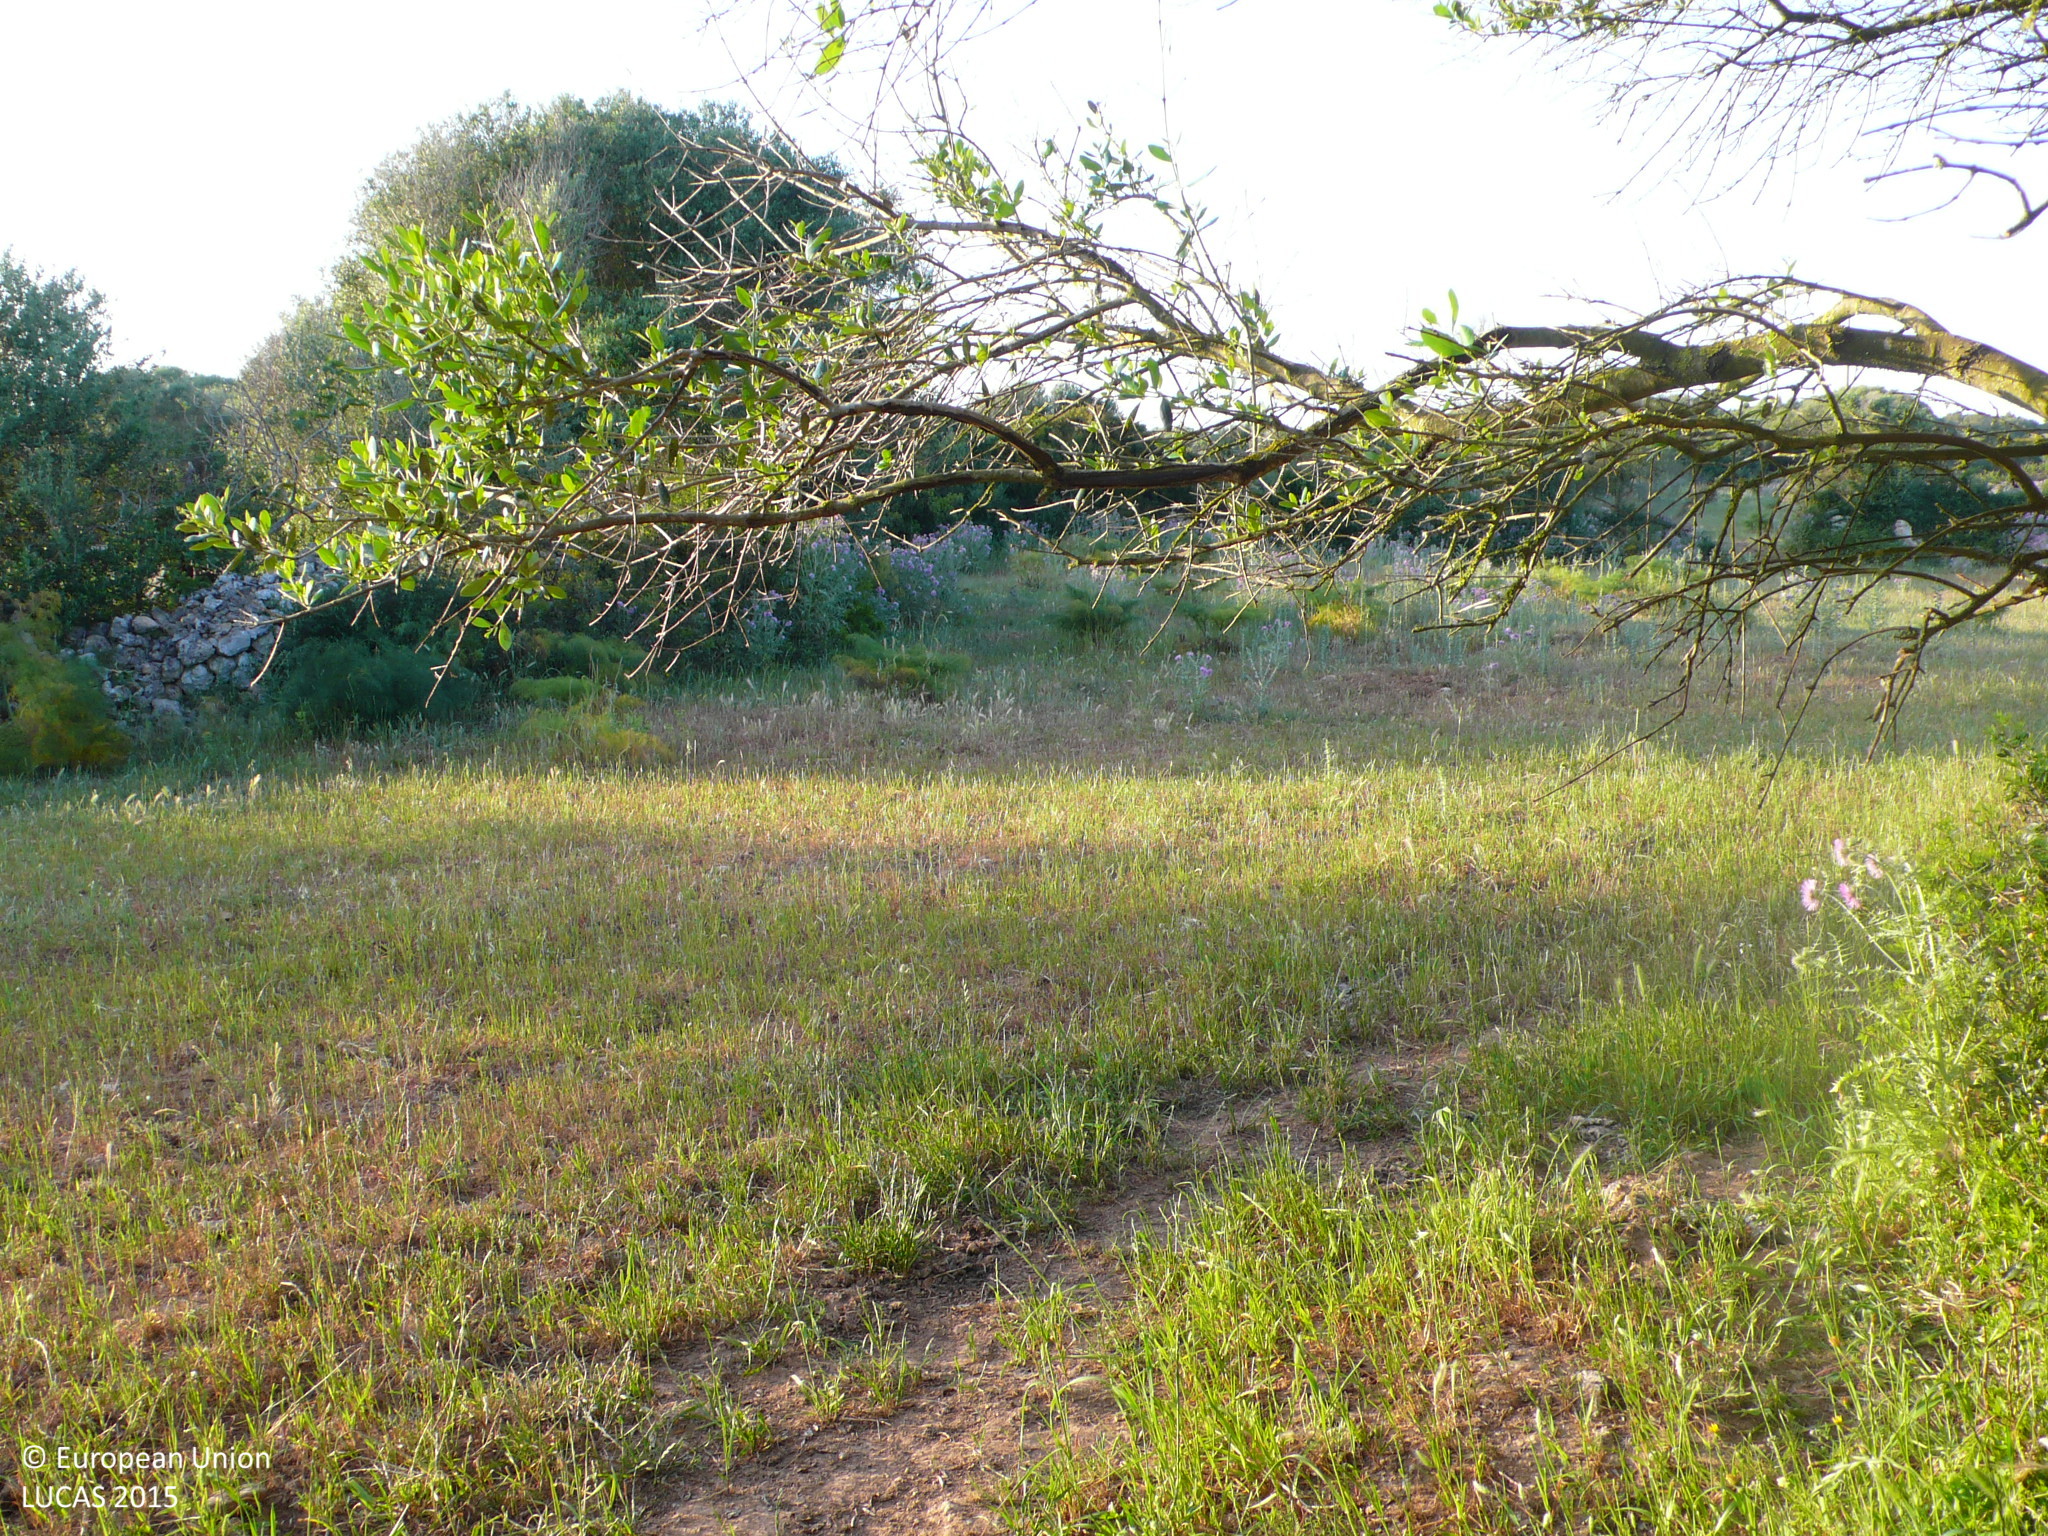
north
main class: Woodland
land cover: Broadleaved woodland
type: broadleaved evergreen forest
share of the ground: 50 - 75 %
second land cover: Grassland without tree/shrub cover
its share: > 75 %
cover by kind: broadleaved forest trees 60 %, shrubs 20 %, herbaceous plants 20 %
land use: Forestry
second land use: Agriculture (excluding fallow land and kitchen gardens)
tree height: > 5 m
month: May
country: ES
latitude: 39.9135
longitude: 4.1885
